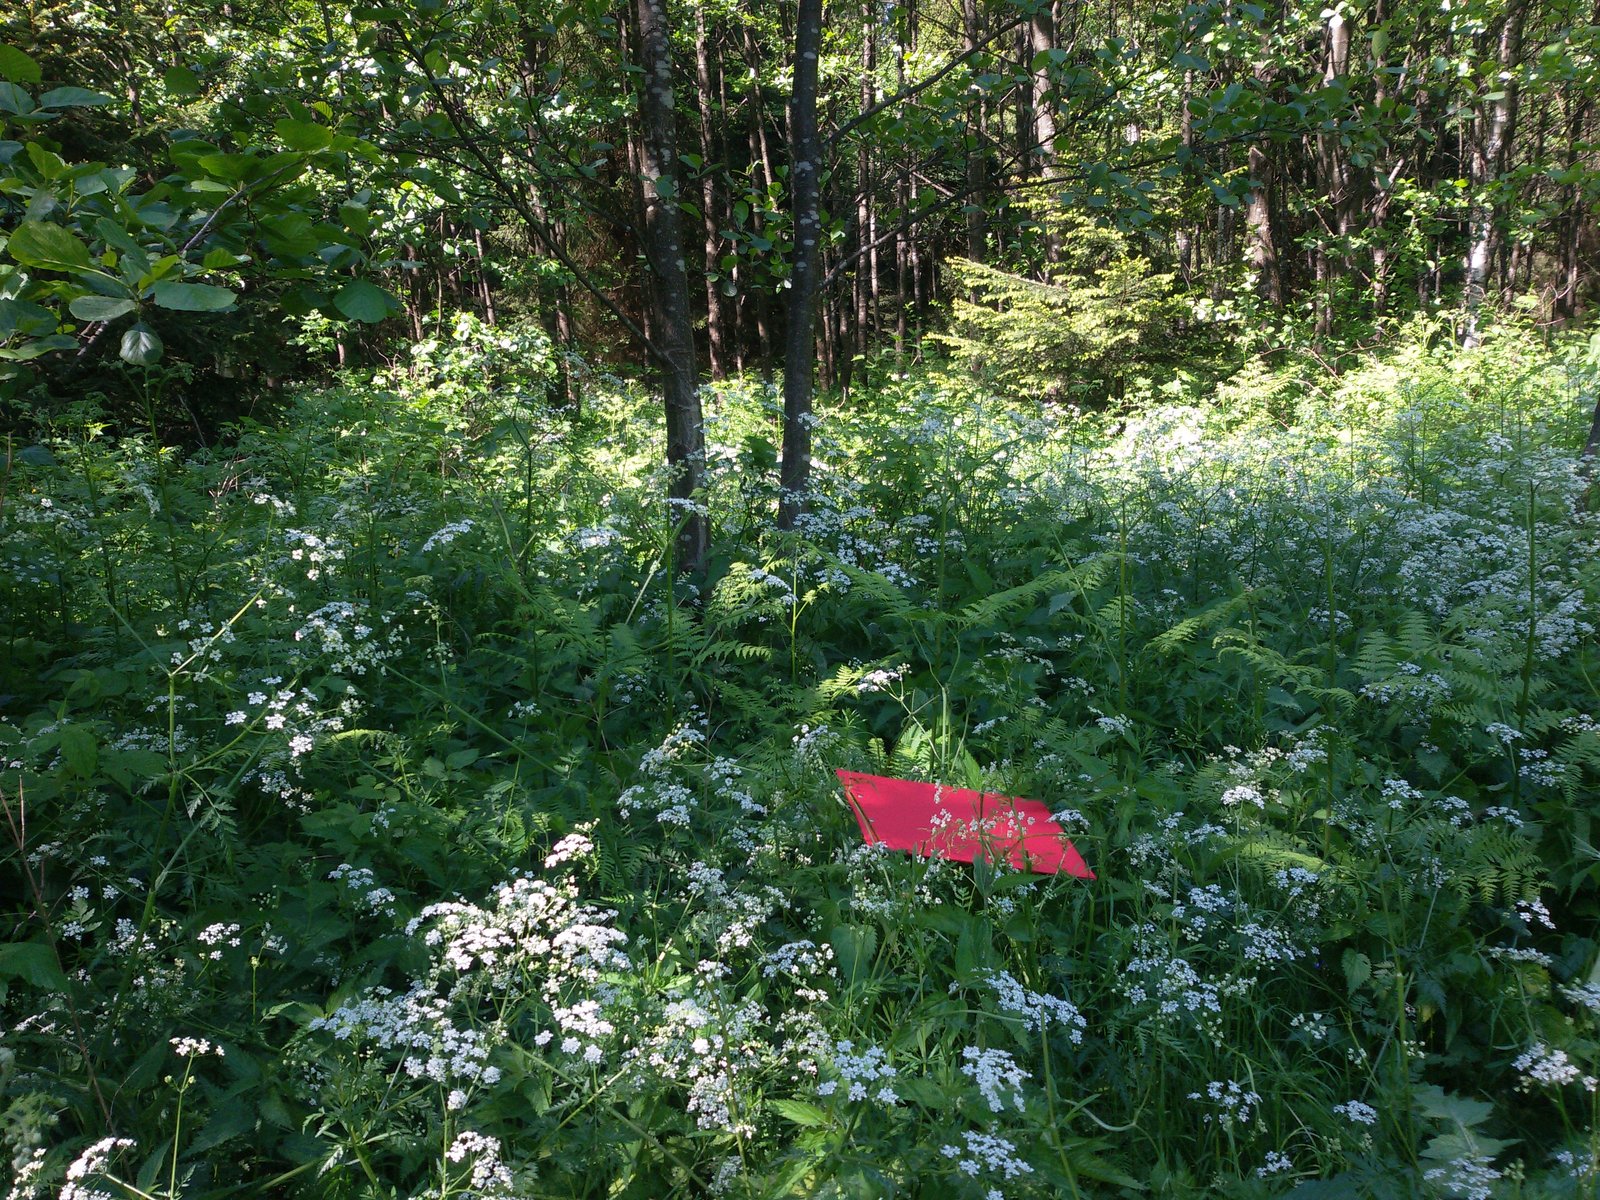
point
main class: Woodland
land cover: Broadleaved woodland
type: mesophytic deciduous forest
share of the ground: > 75 %
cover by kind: broadleaved forest trees 85 %, coniferous forest trees 5 %, shrubs 5 %, herbaceous plants 5 %
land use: Forestry
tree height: > 5 m
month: June
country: PL
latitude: 53.4860
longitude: 21.5190
